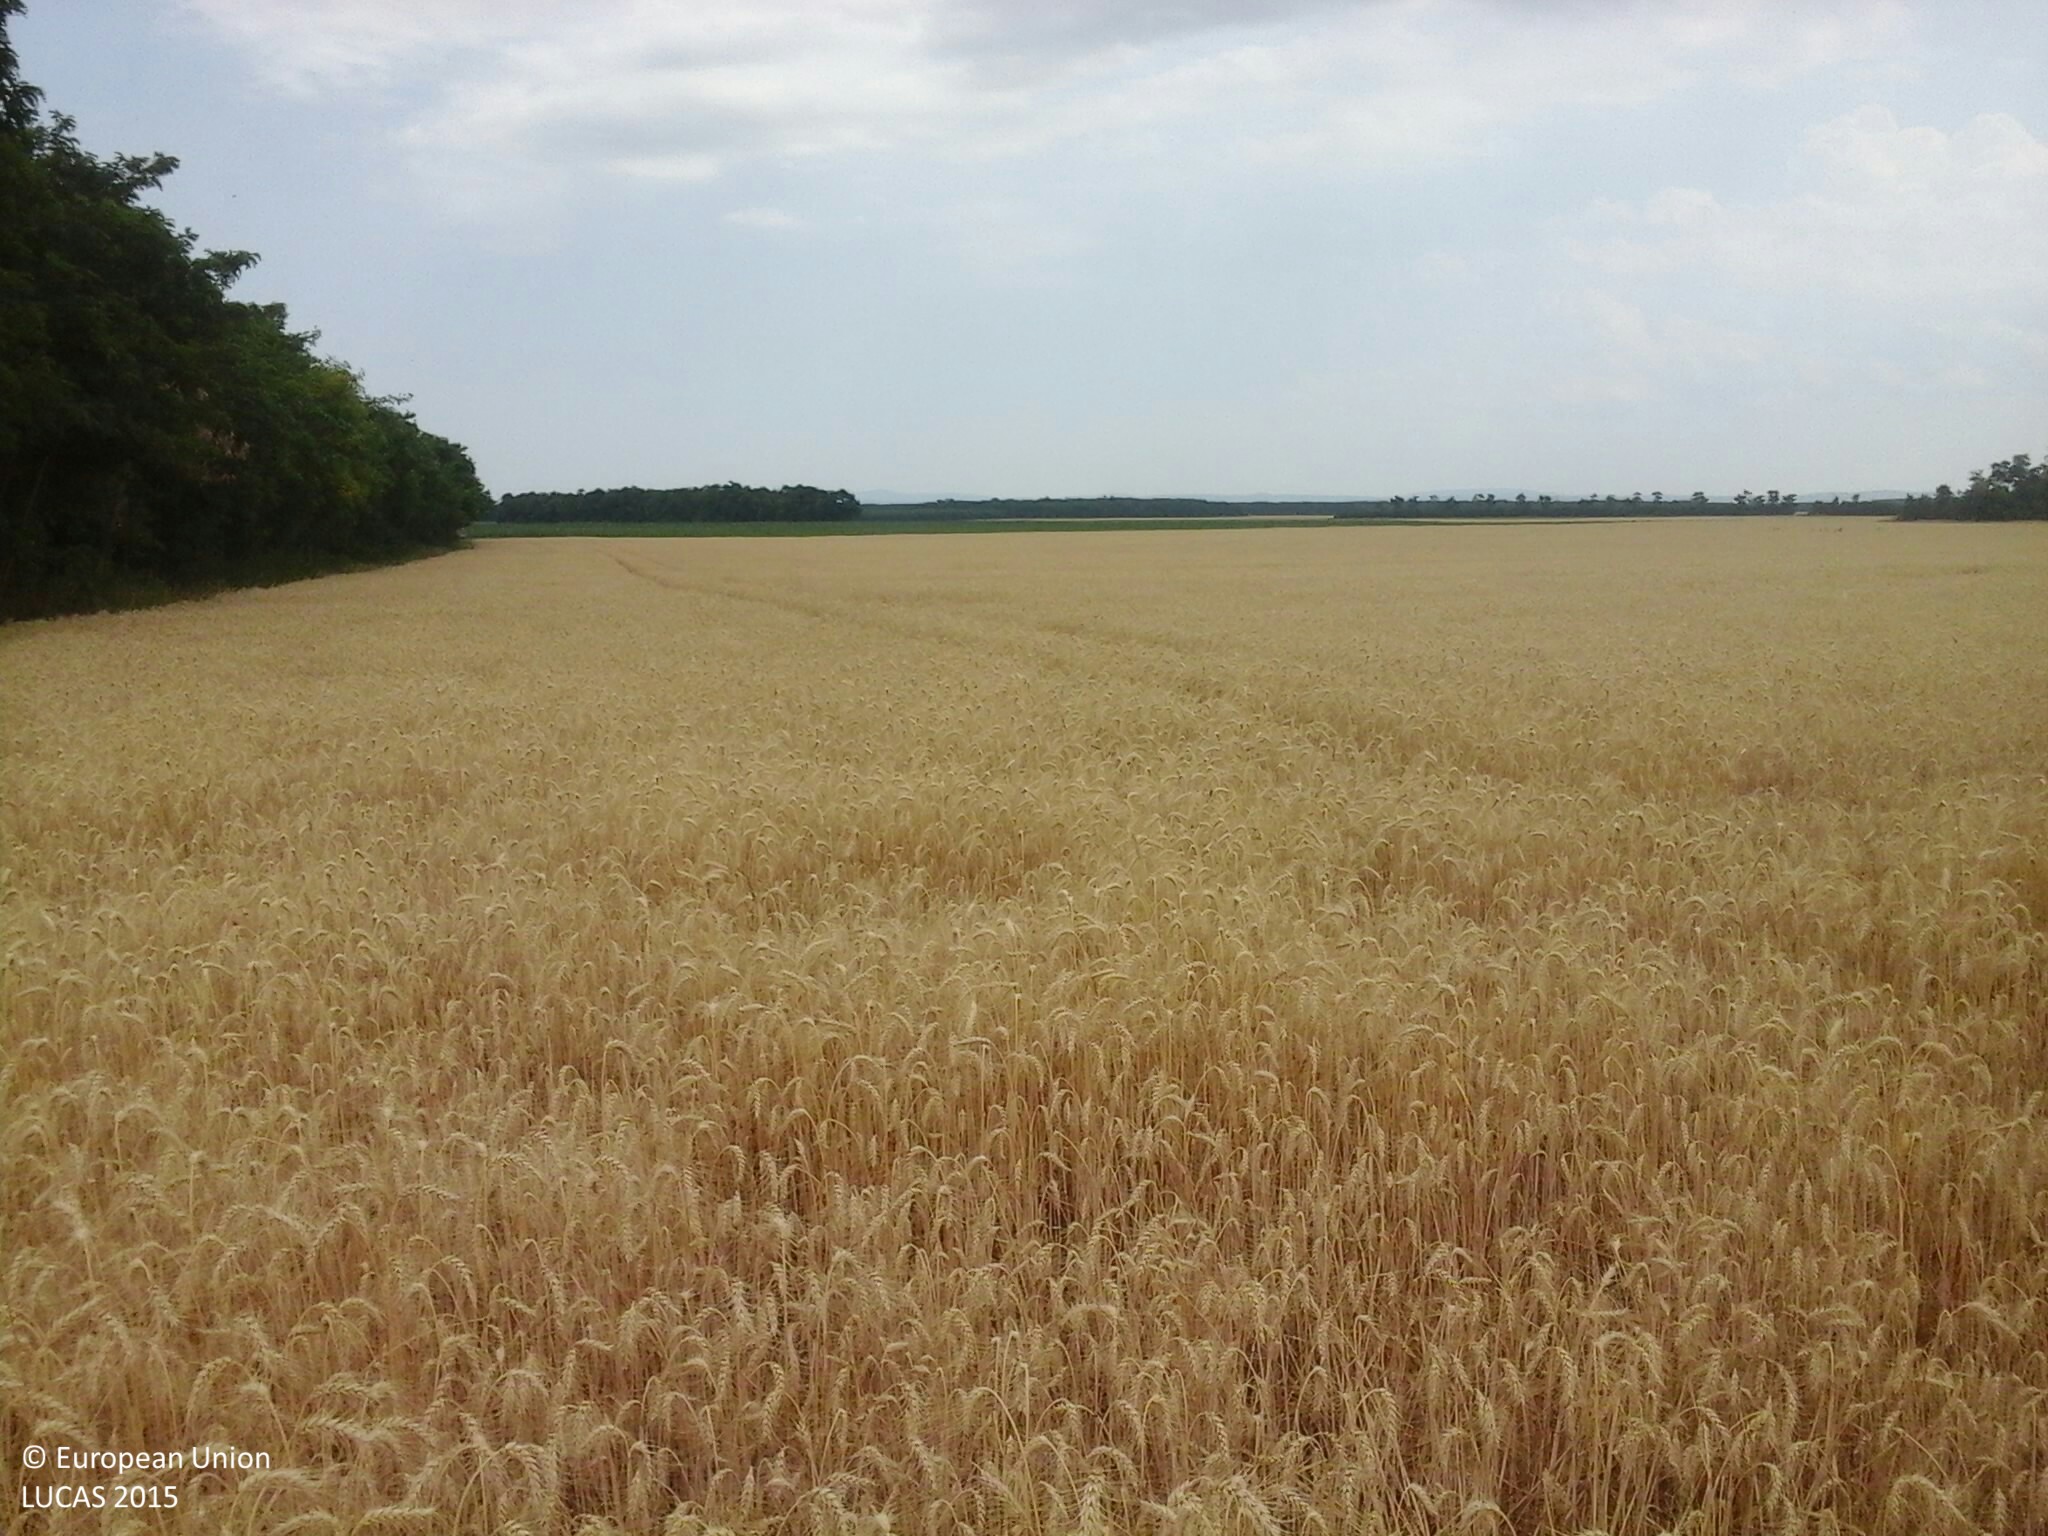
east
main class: Cropland
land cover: Common wheat
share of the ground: > 75 %
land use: Agriculture (excluding fallow land and kitchen gardens)
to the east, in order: Common wheat
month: July
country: HU
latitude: 47.2629
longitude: 17.2352
